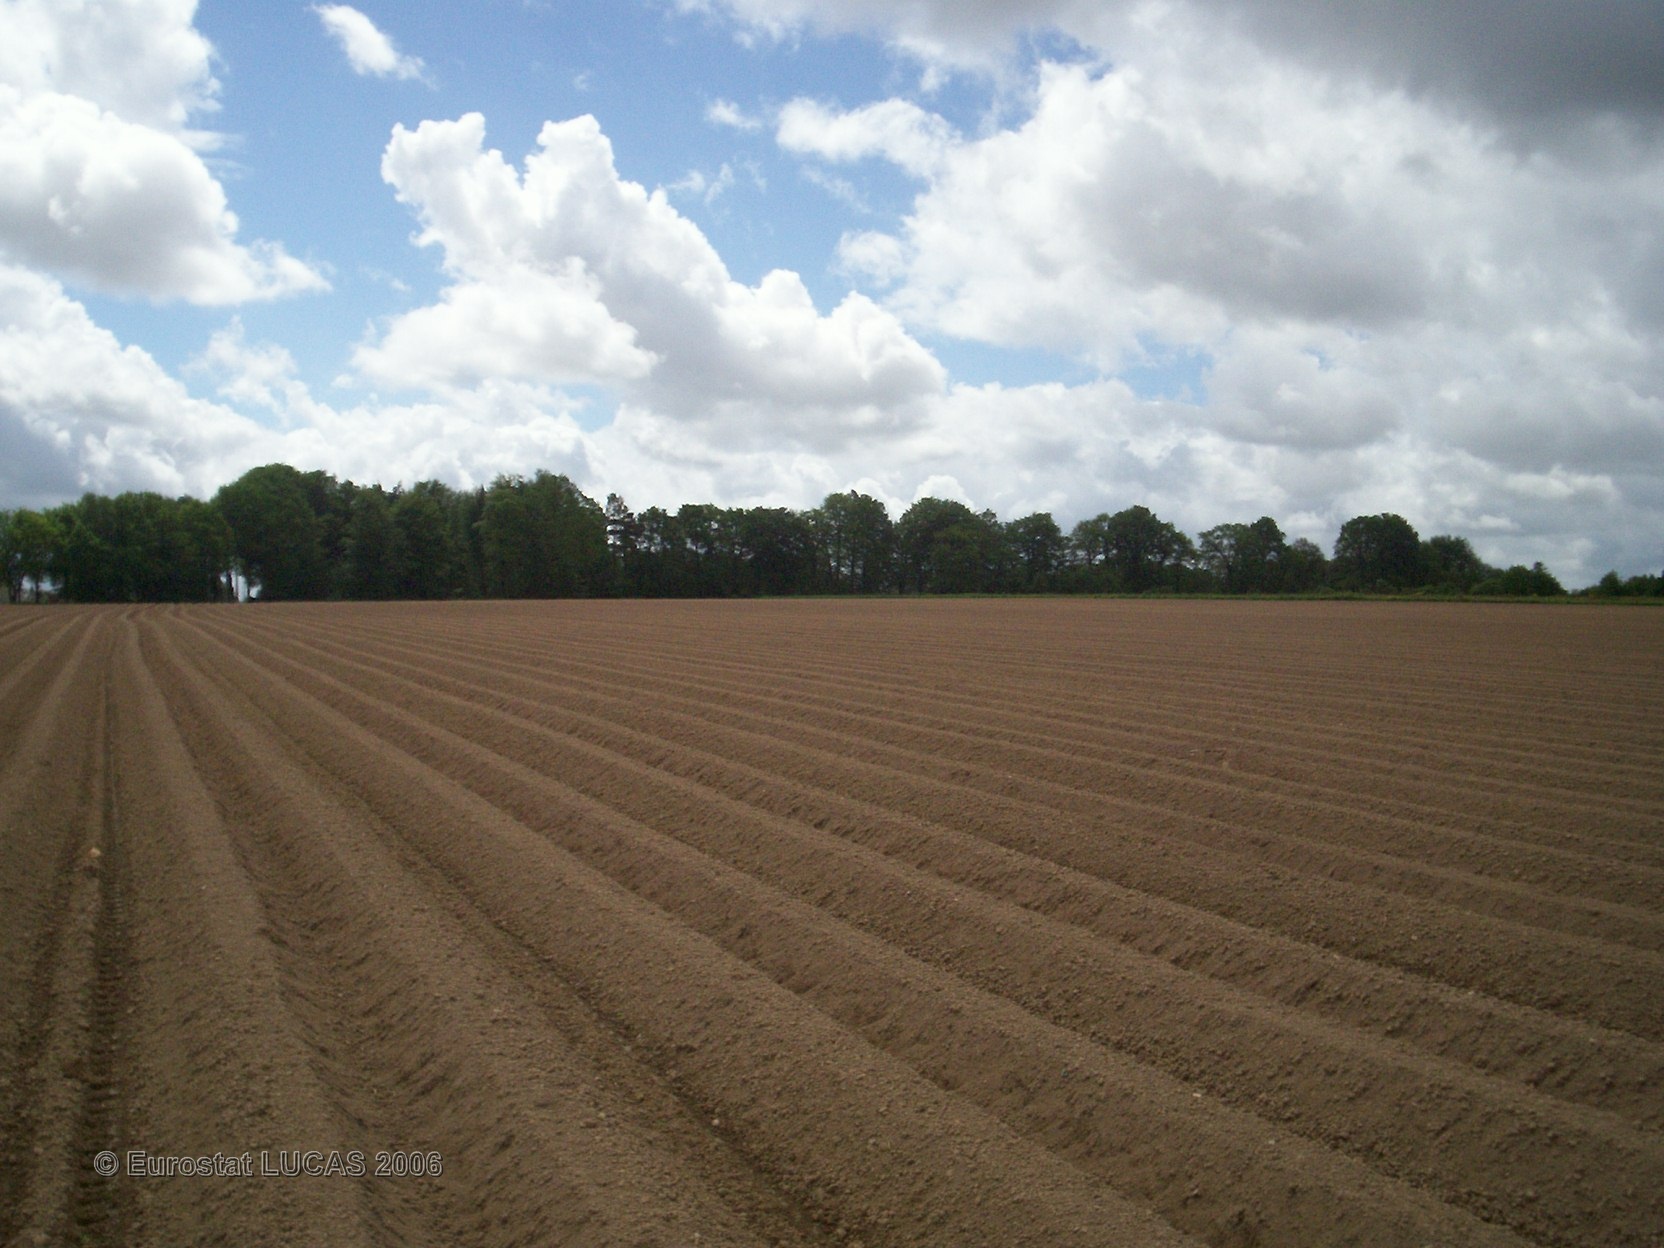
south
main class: Cropland
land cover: Potatoes
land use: Agriculture (excluding fallow land and kitchen gardens)
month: May
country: FR
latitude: 47.9892
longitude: -2.7532
